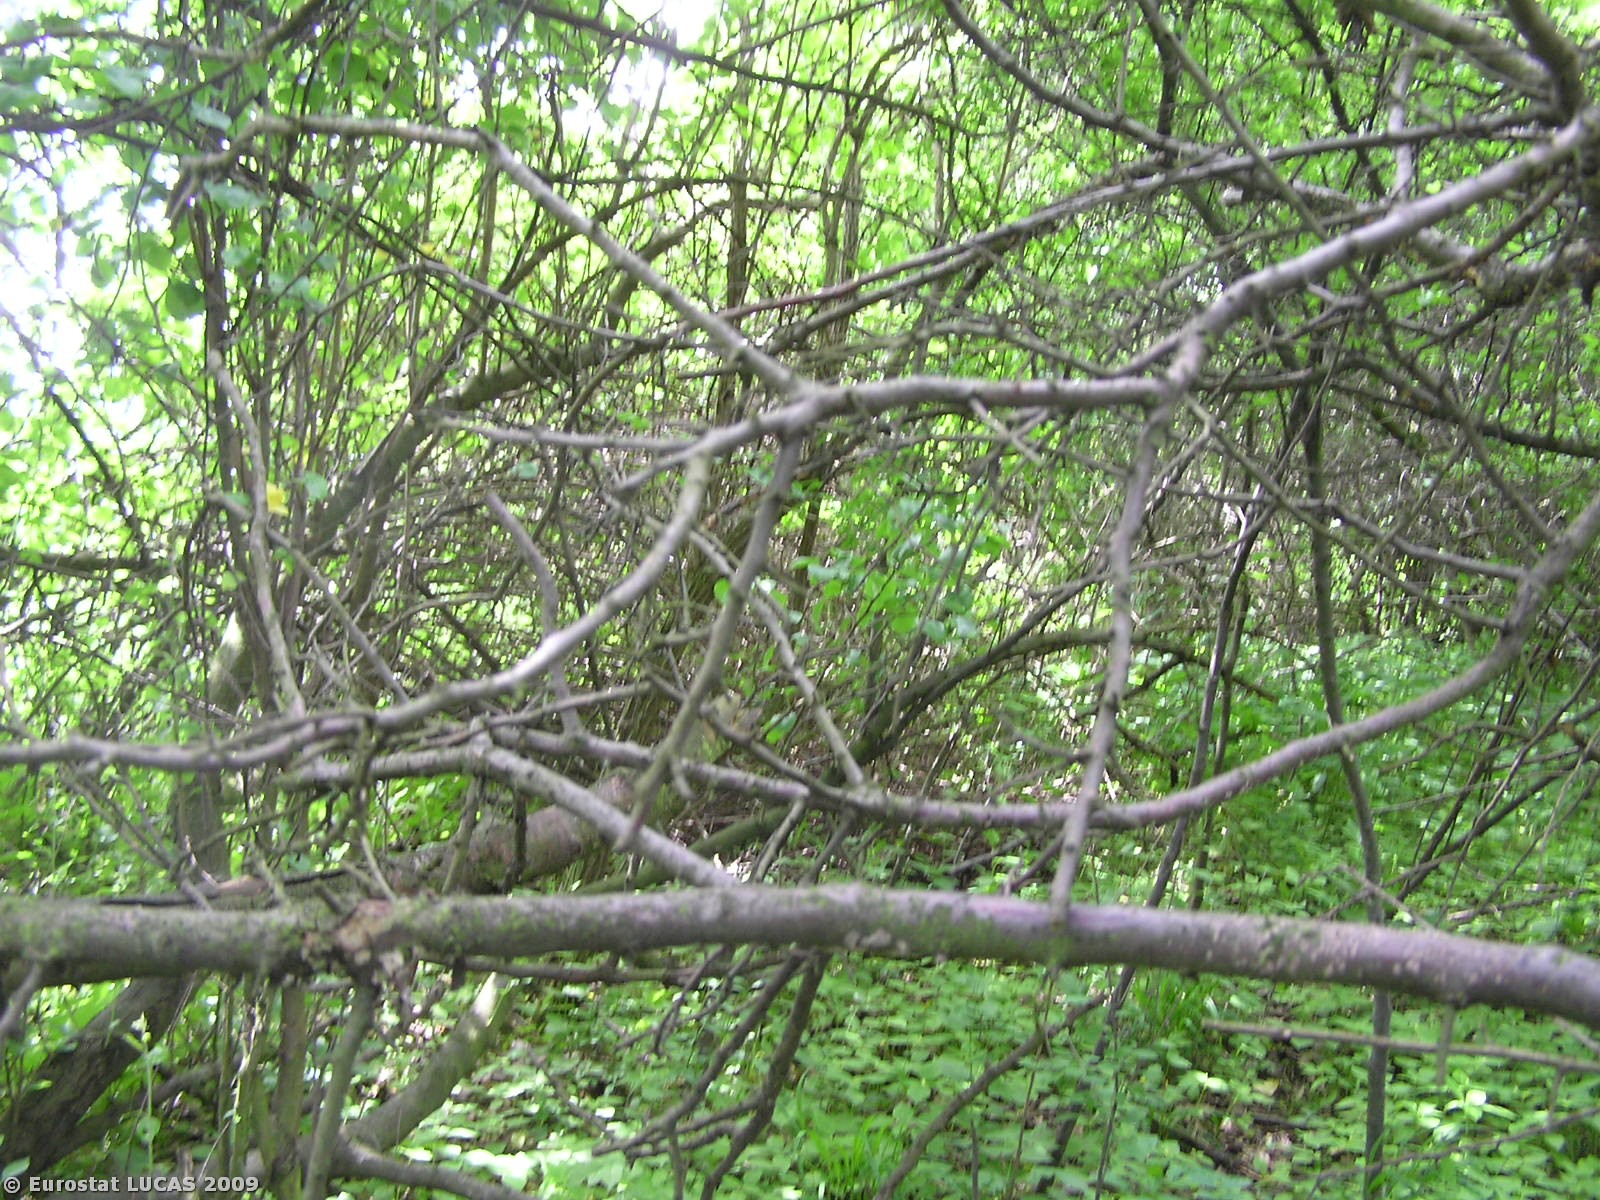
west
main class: Woodland
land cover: Broadleaved woodland
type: non-riverine alder, birch or aspen forest
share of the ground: > 75 %
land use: Unused
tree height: > 5 m
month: June
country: CZ
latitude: 50.1802
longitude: 17.6454
